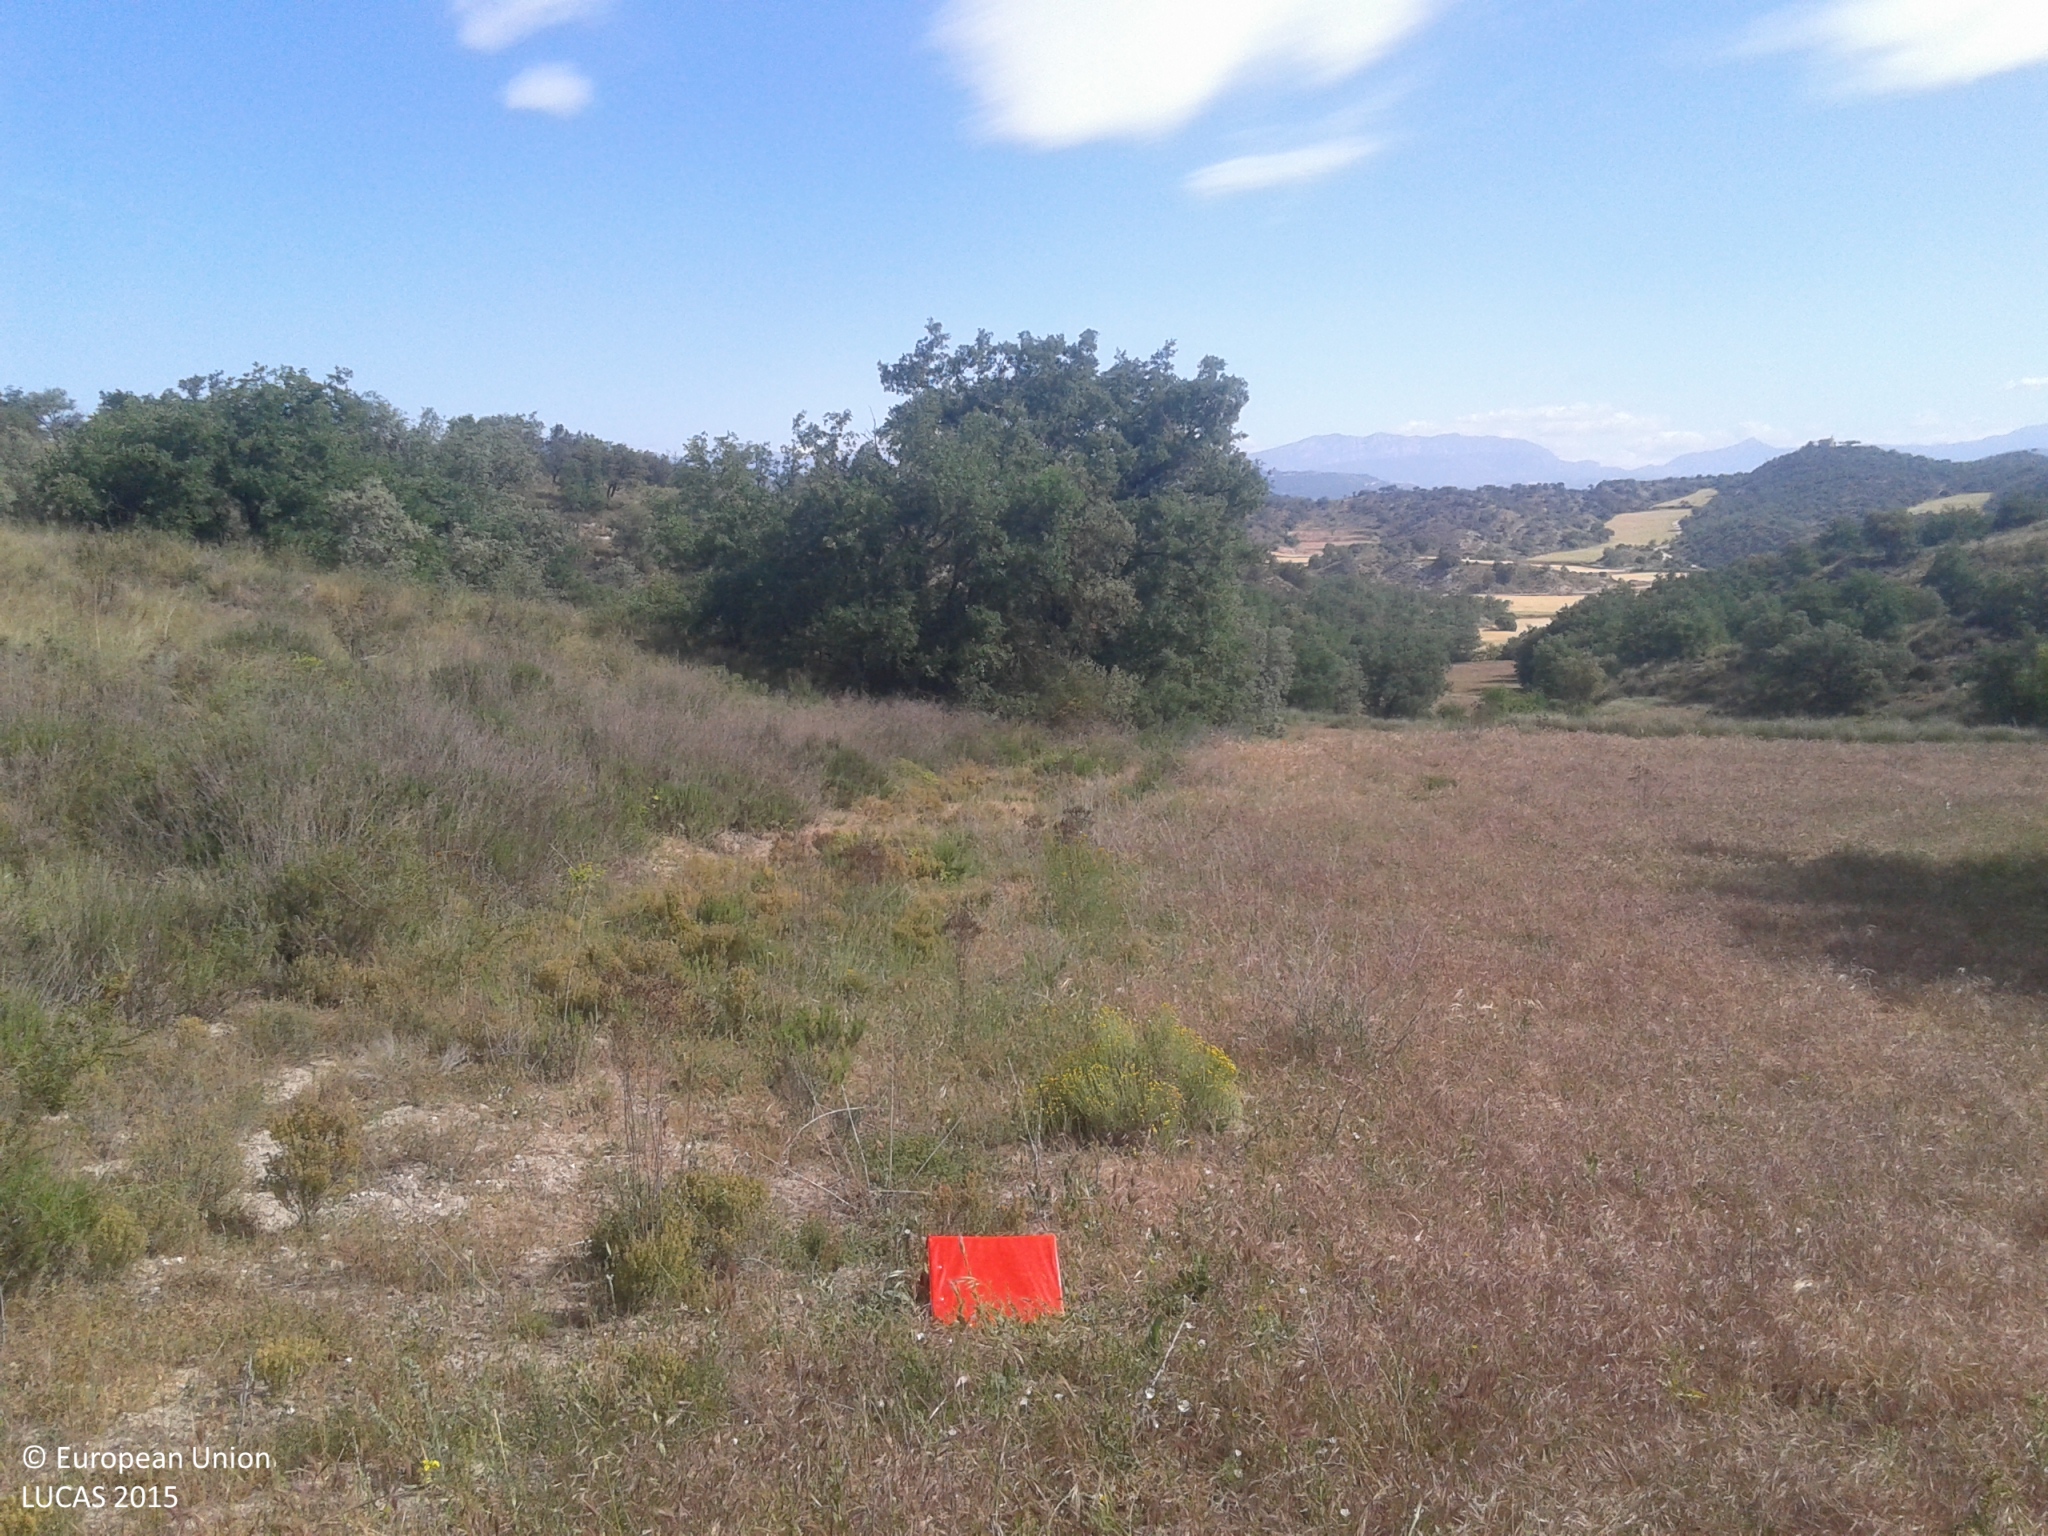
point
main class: Grassland
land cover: Spontaneously vegetated surfaces
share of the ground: > 75 %
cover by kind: herbaceous plants 100 %
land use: Fallow land
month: May
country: ES
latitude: 41.8670
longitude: 1.1570
